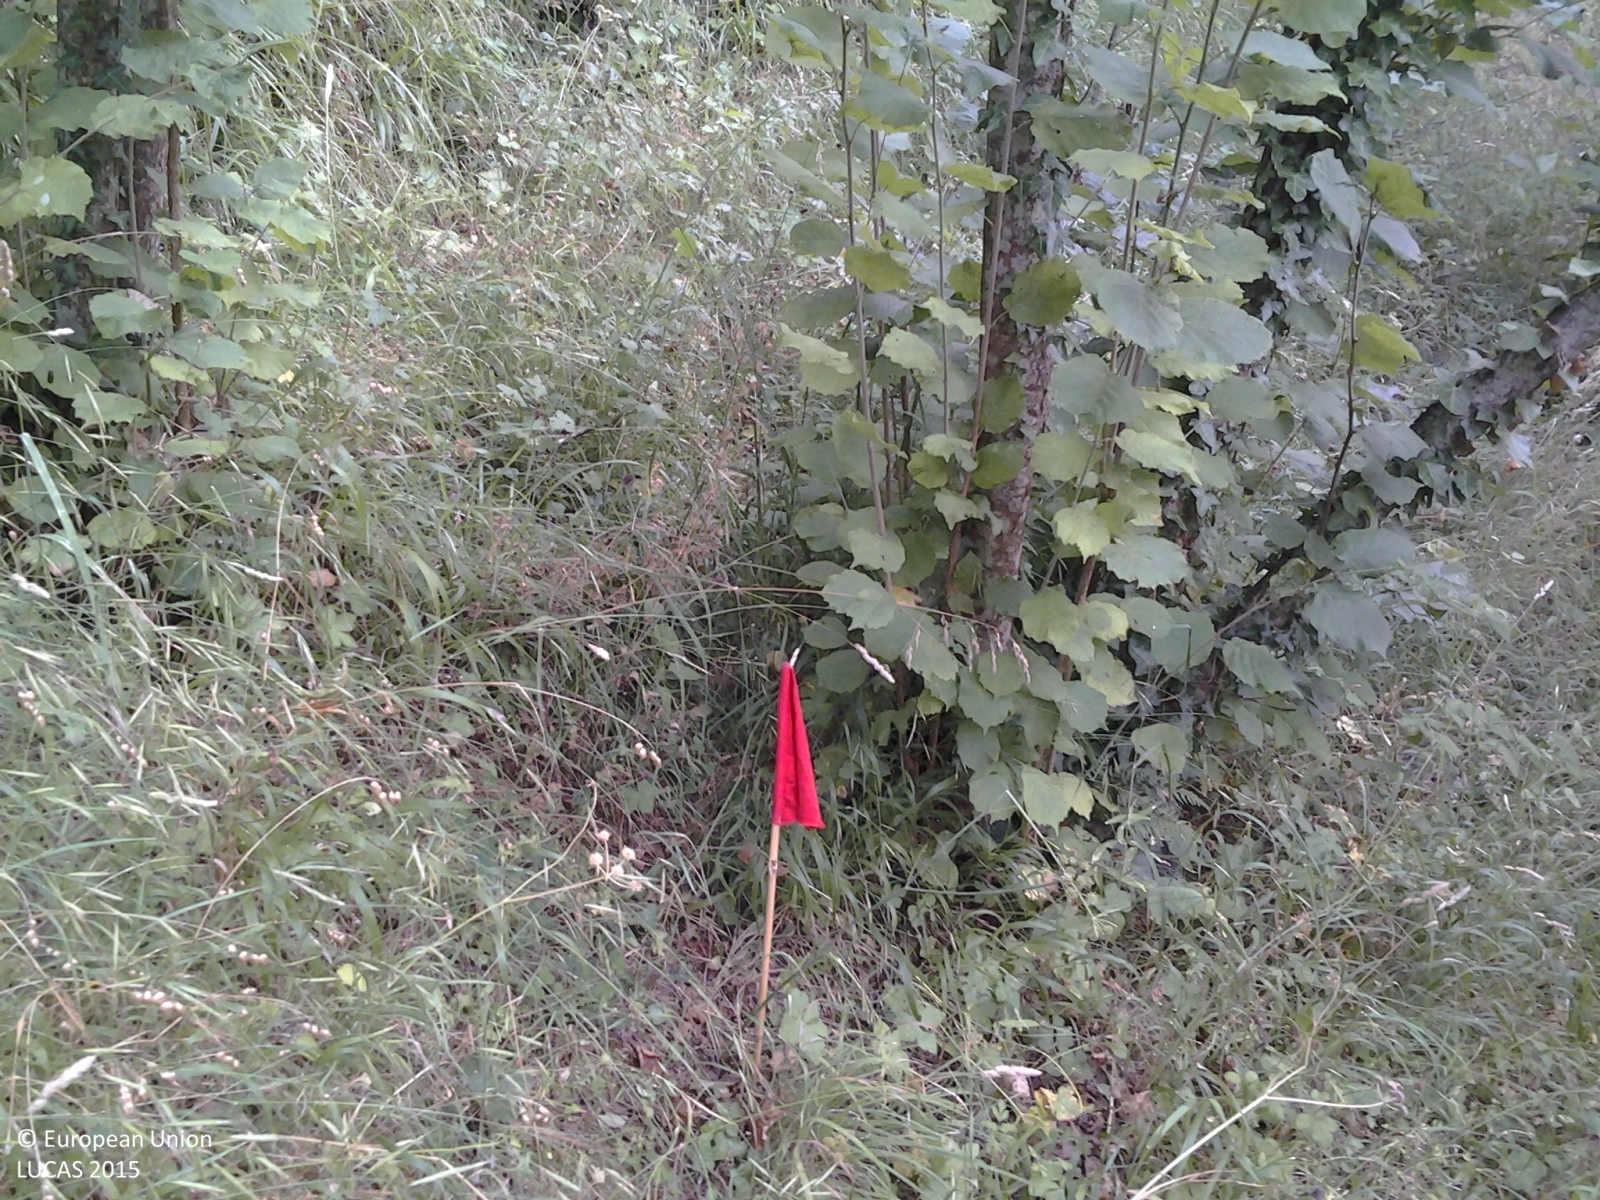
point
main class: Cropland
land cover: Nuts trees
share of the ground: > 75 %
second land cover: Spontaneously vegetated surfaces
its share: > 75 %
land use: Agriculture (excluding fallow land and kitchen gardens)
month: July
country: IT
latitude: 38.0585
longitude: 14.8797
